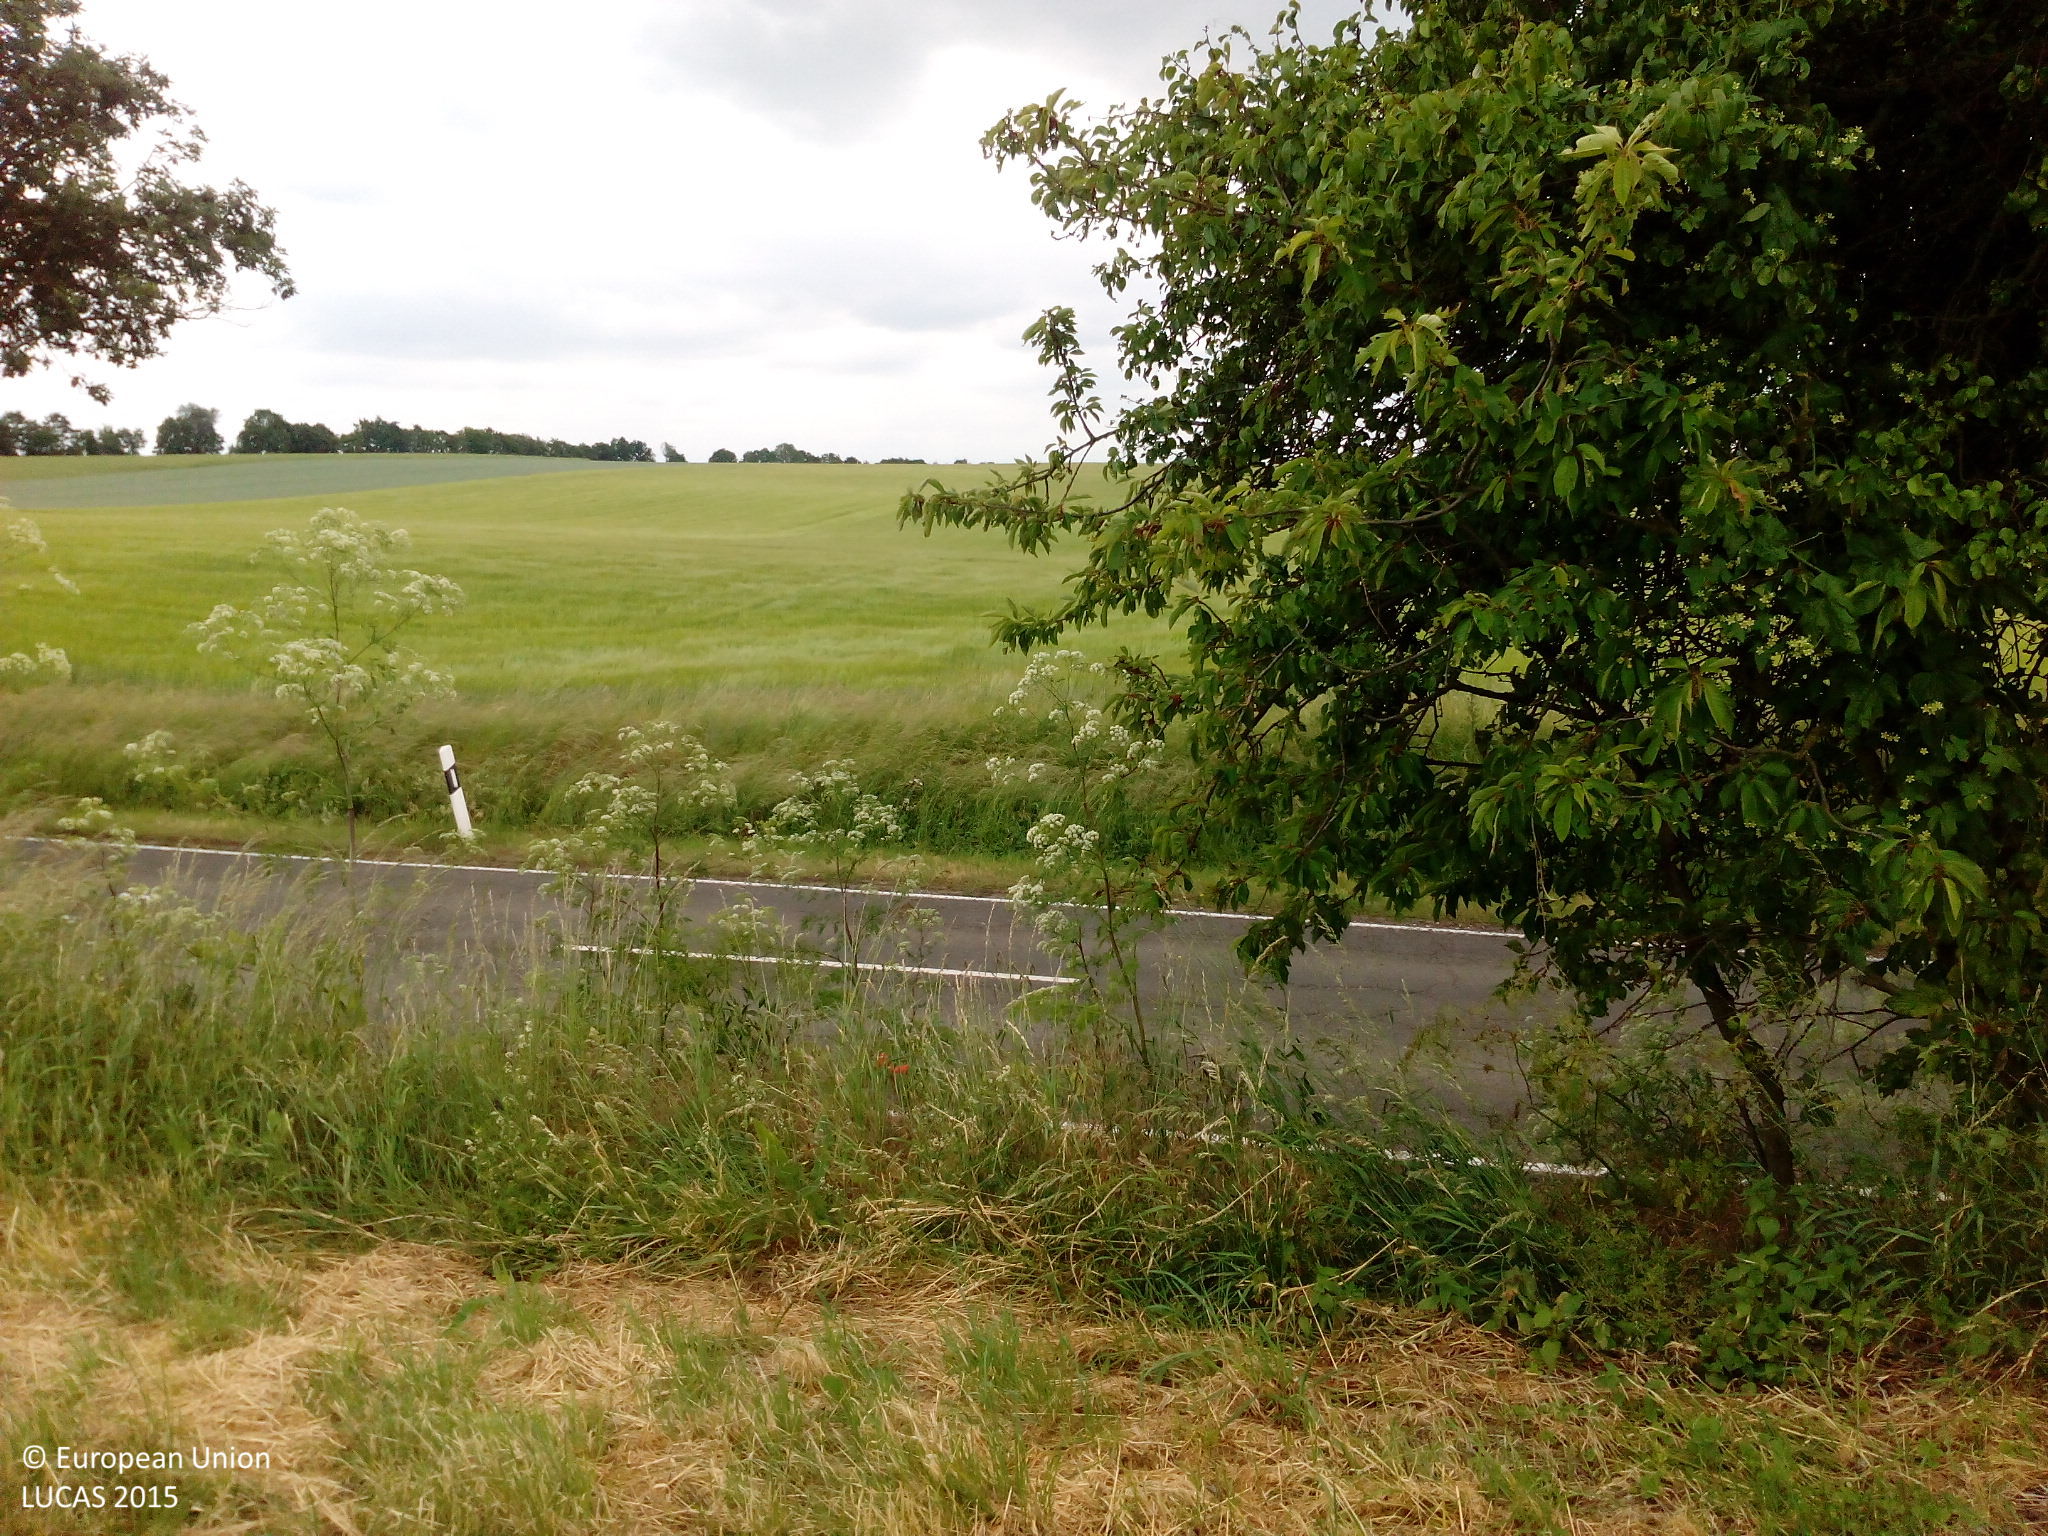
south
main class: Cropland
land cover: Common wheat
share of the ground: > 75 %
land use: Agriculture (excluding fallow land and kitchen gardens)
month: June
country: DE
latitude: 49.7537
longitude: 8.0434
